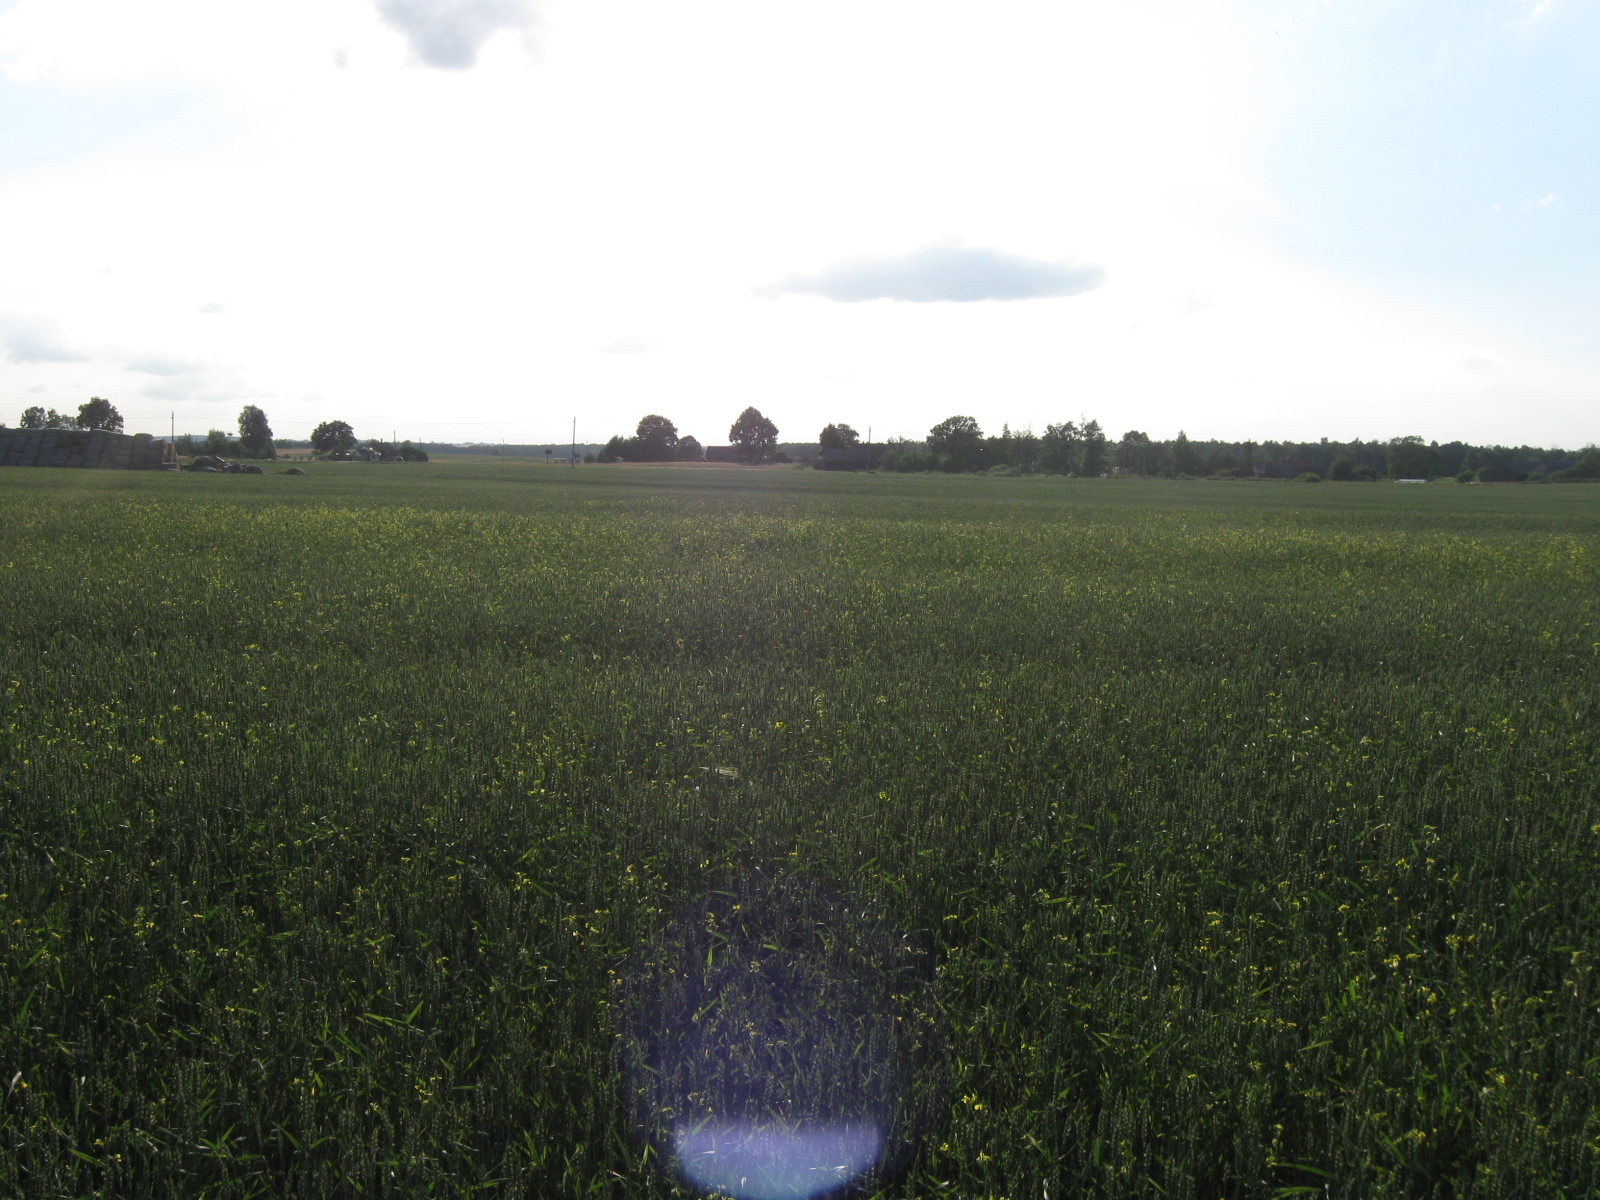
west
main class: Cropland
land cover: Common wheat
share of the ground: > 75 %
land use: Agriculture (excluding fallow land and kitchen gardens)
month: July
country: LT
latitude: 54.3571
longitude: 23.3277
